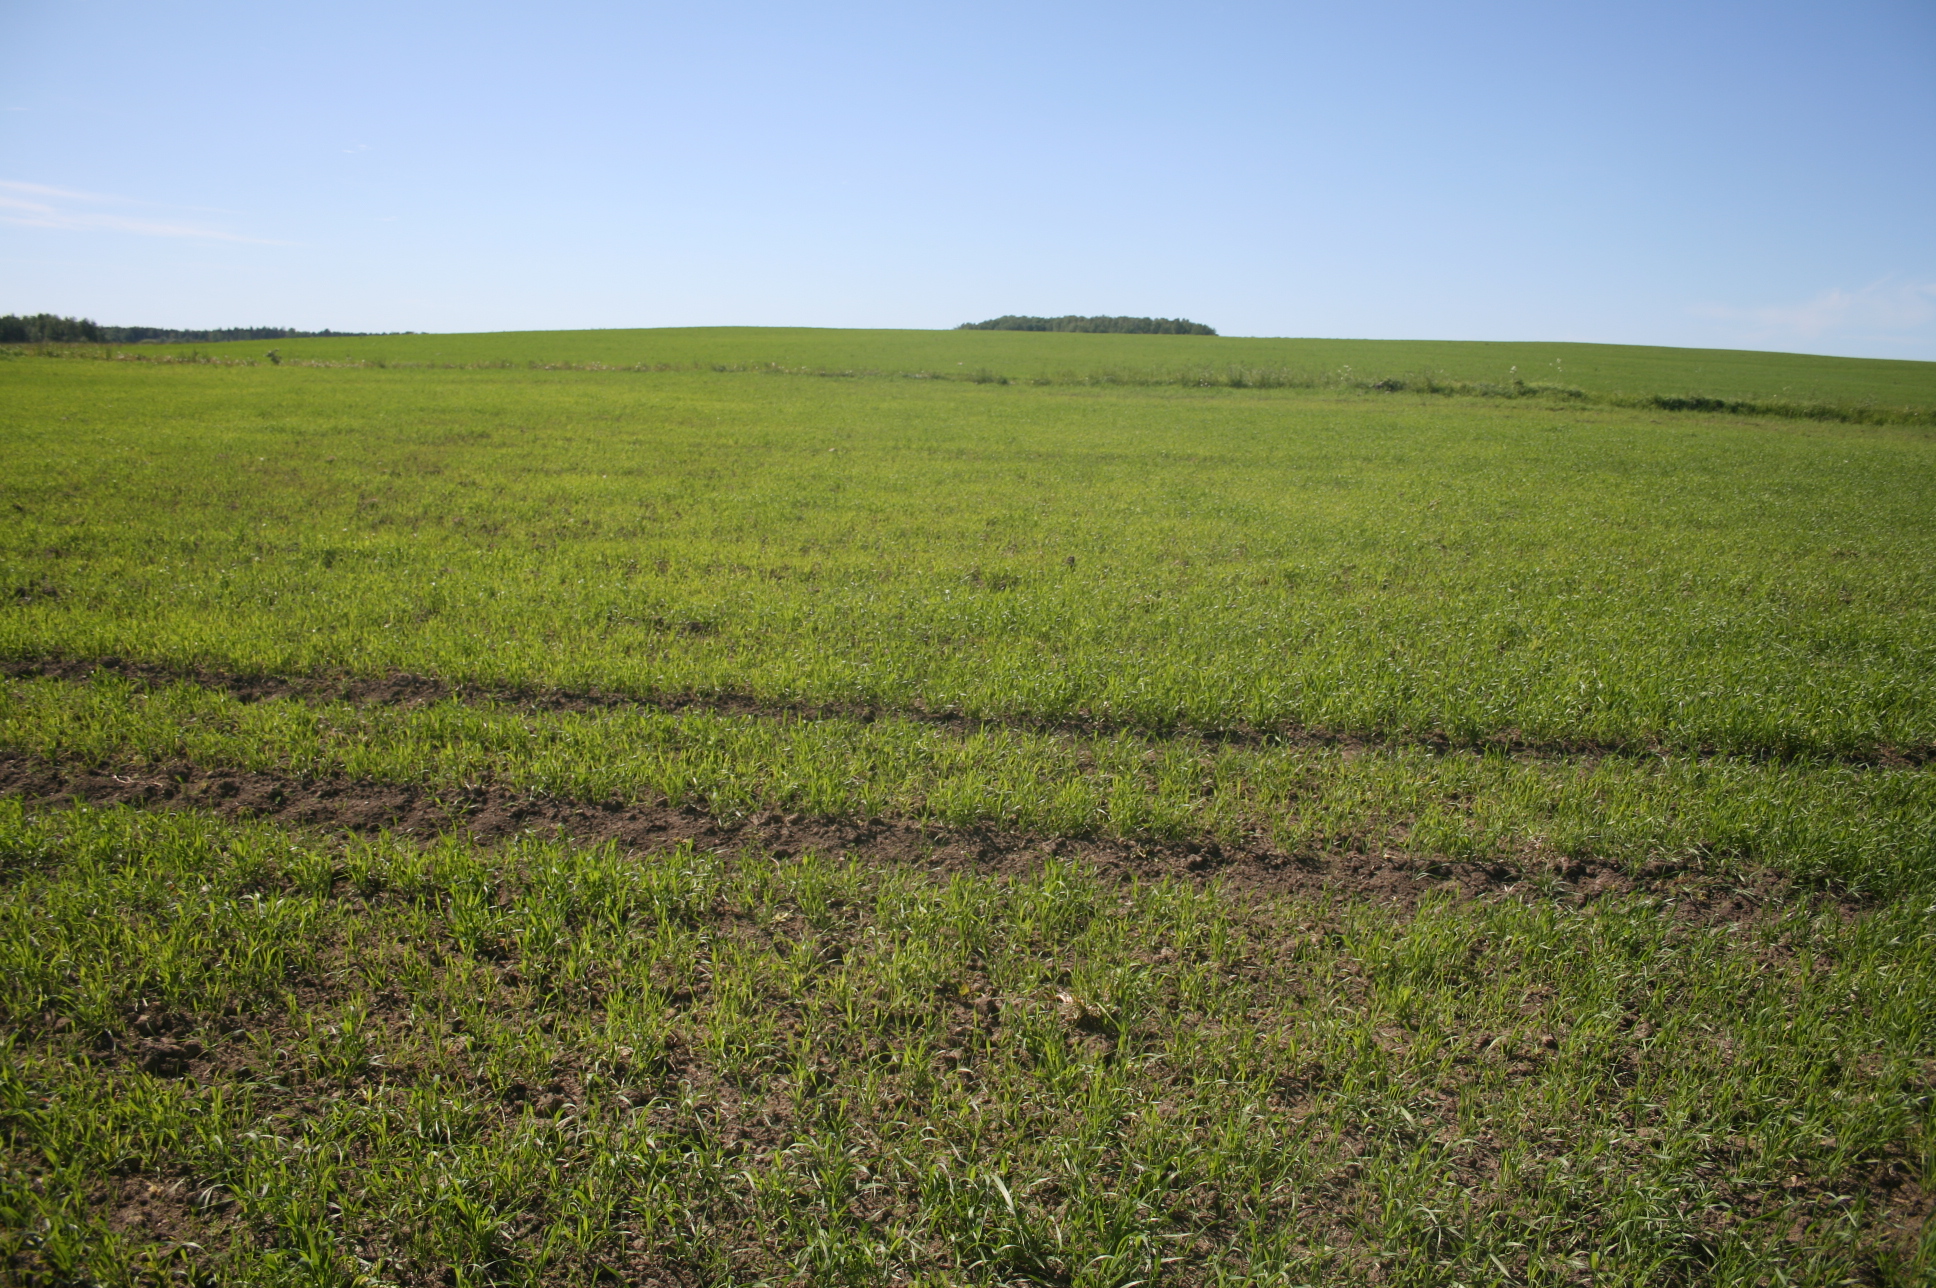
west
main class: Cropland
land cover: Common wheat
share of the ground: > 75 %
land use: Agriculture (excluding fallow land and kitchen gardens)
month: June
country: LT
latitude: 55.9451
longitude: 21.4603
